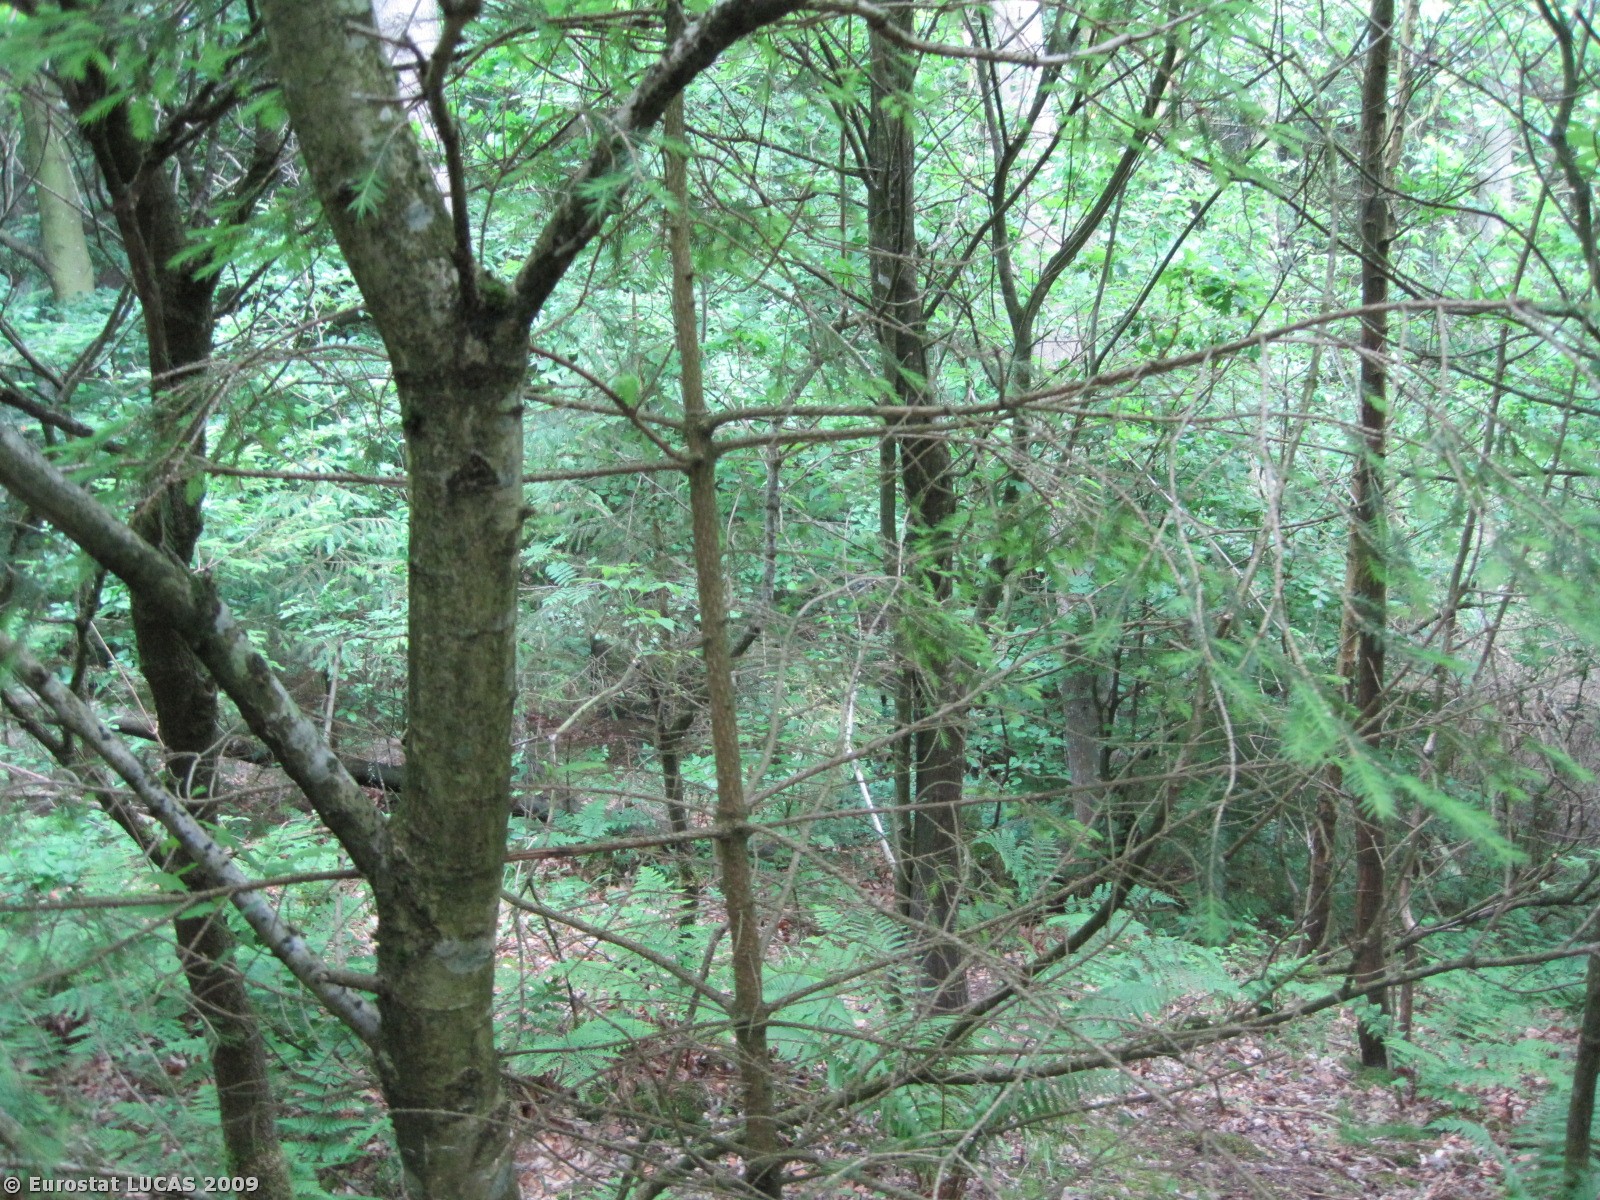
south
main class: Woodland
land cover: Mixed woodland
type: hemiboreal forest and nemoral coniferous forest and mixed broadleaved-coniferous forest
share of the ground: > 75 %
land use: Forestry
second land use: Amenities, museums, leisure
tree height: > 5 m
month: June
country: DK
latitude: 57.1225
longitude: 10.0165
